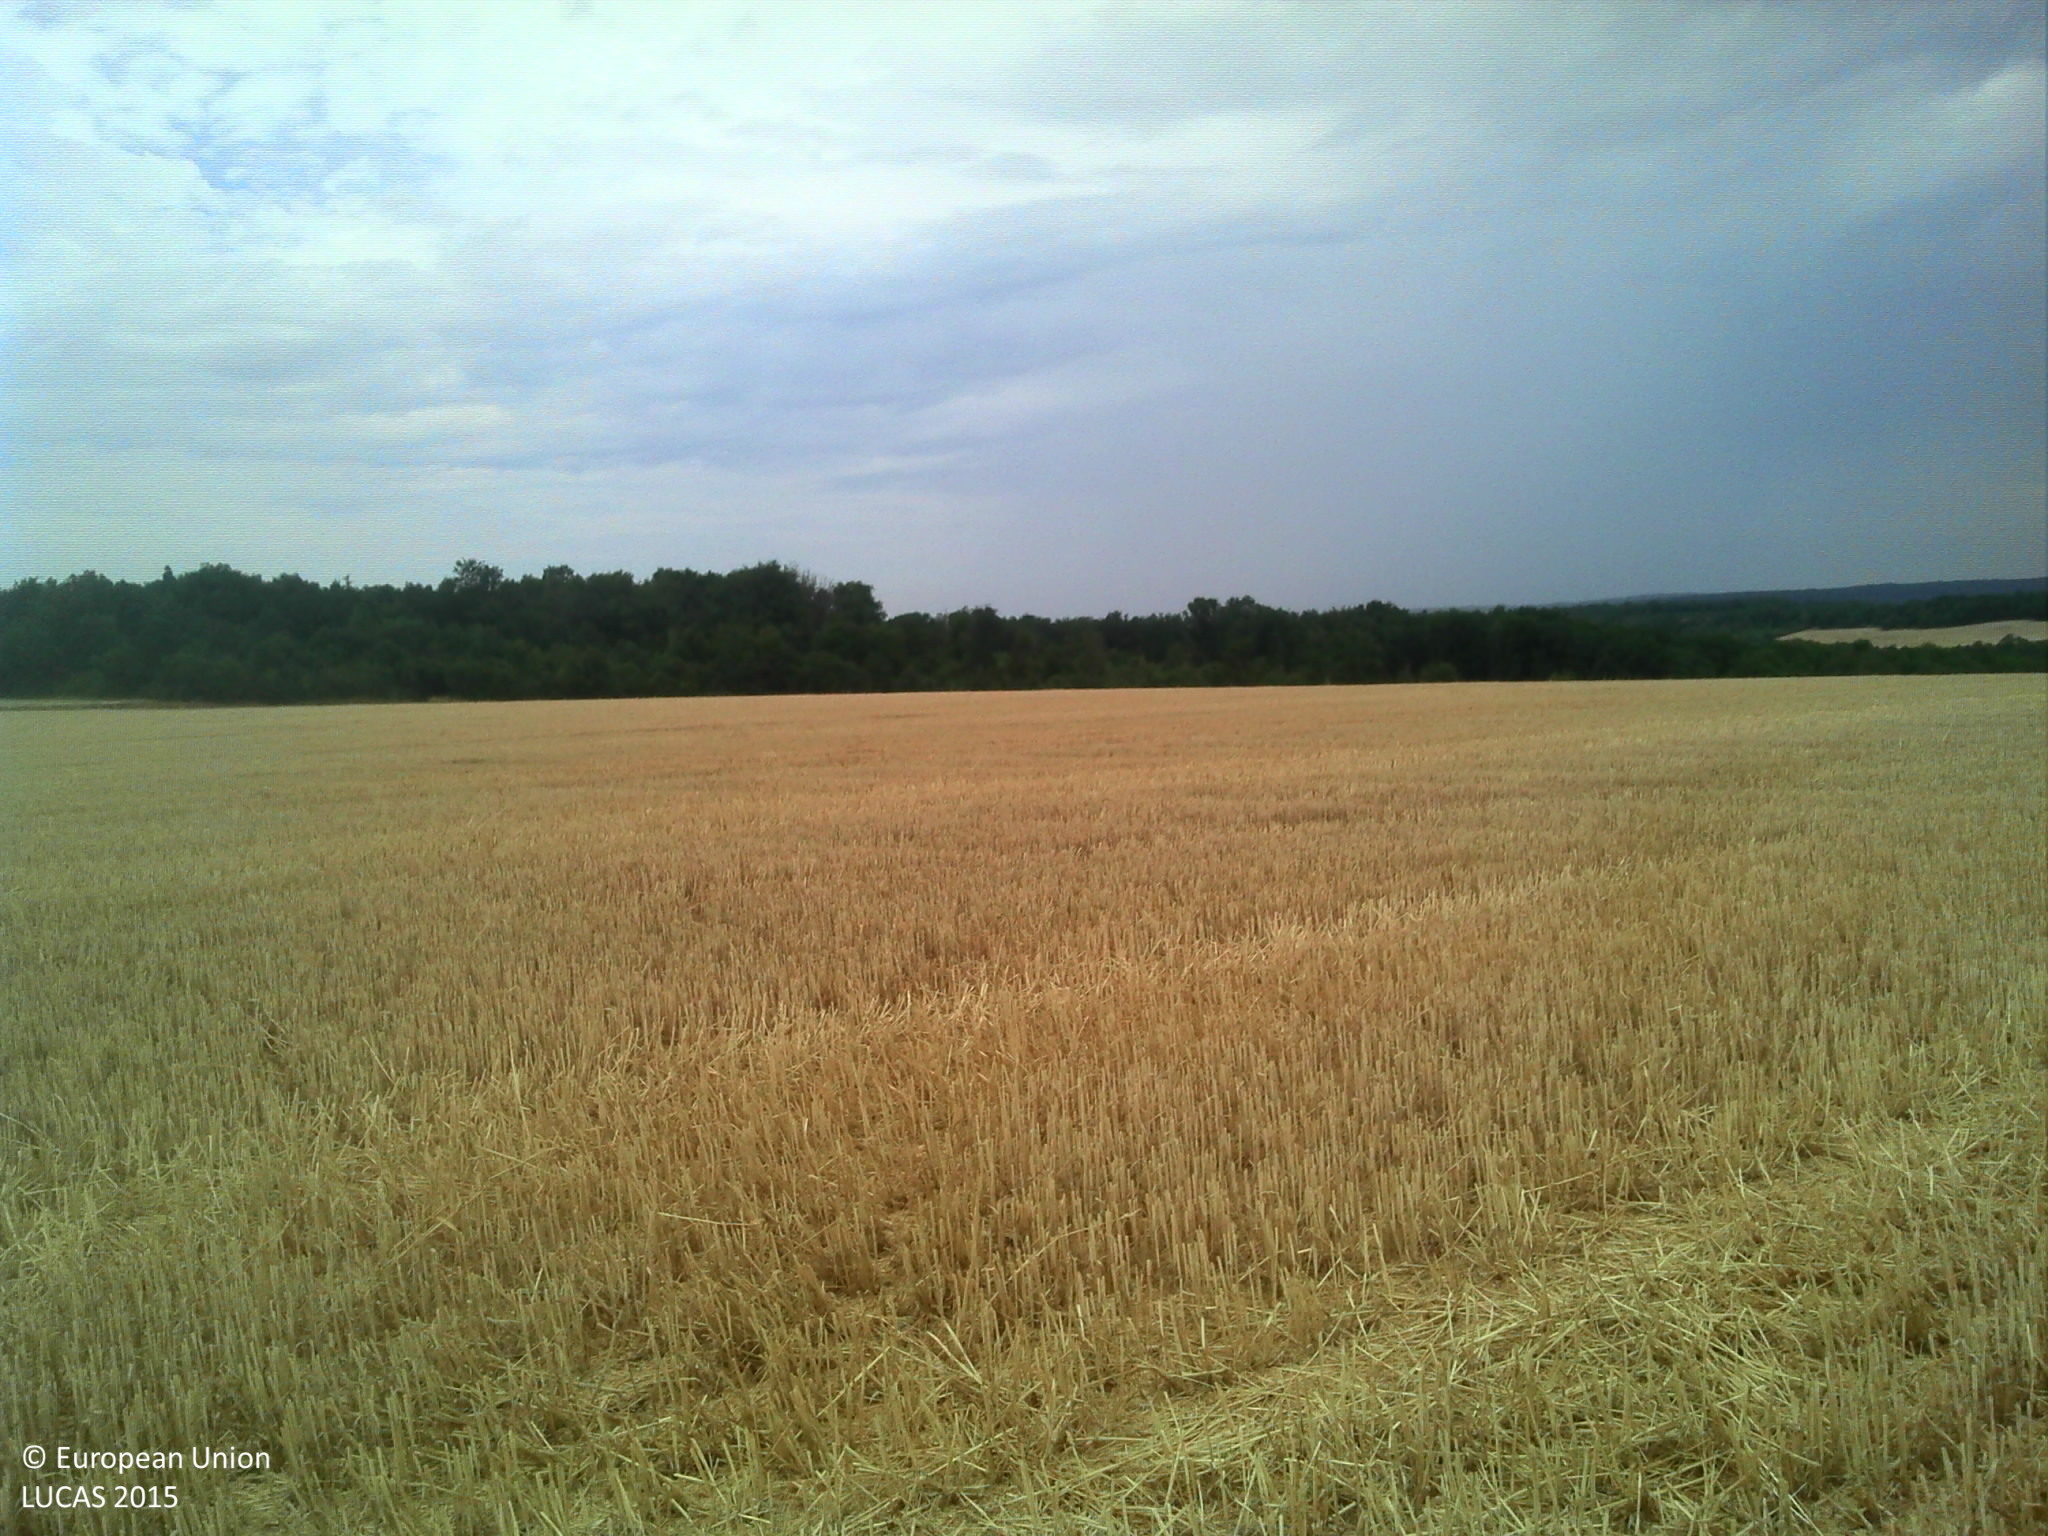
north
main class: Cropland
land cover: Common wheat
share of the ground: 10 - 25 %
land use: Agriculture (excluding fallow land and kitchen gardens)
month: July
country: FR
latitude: 47.9935
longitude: 5.2154
